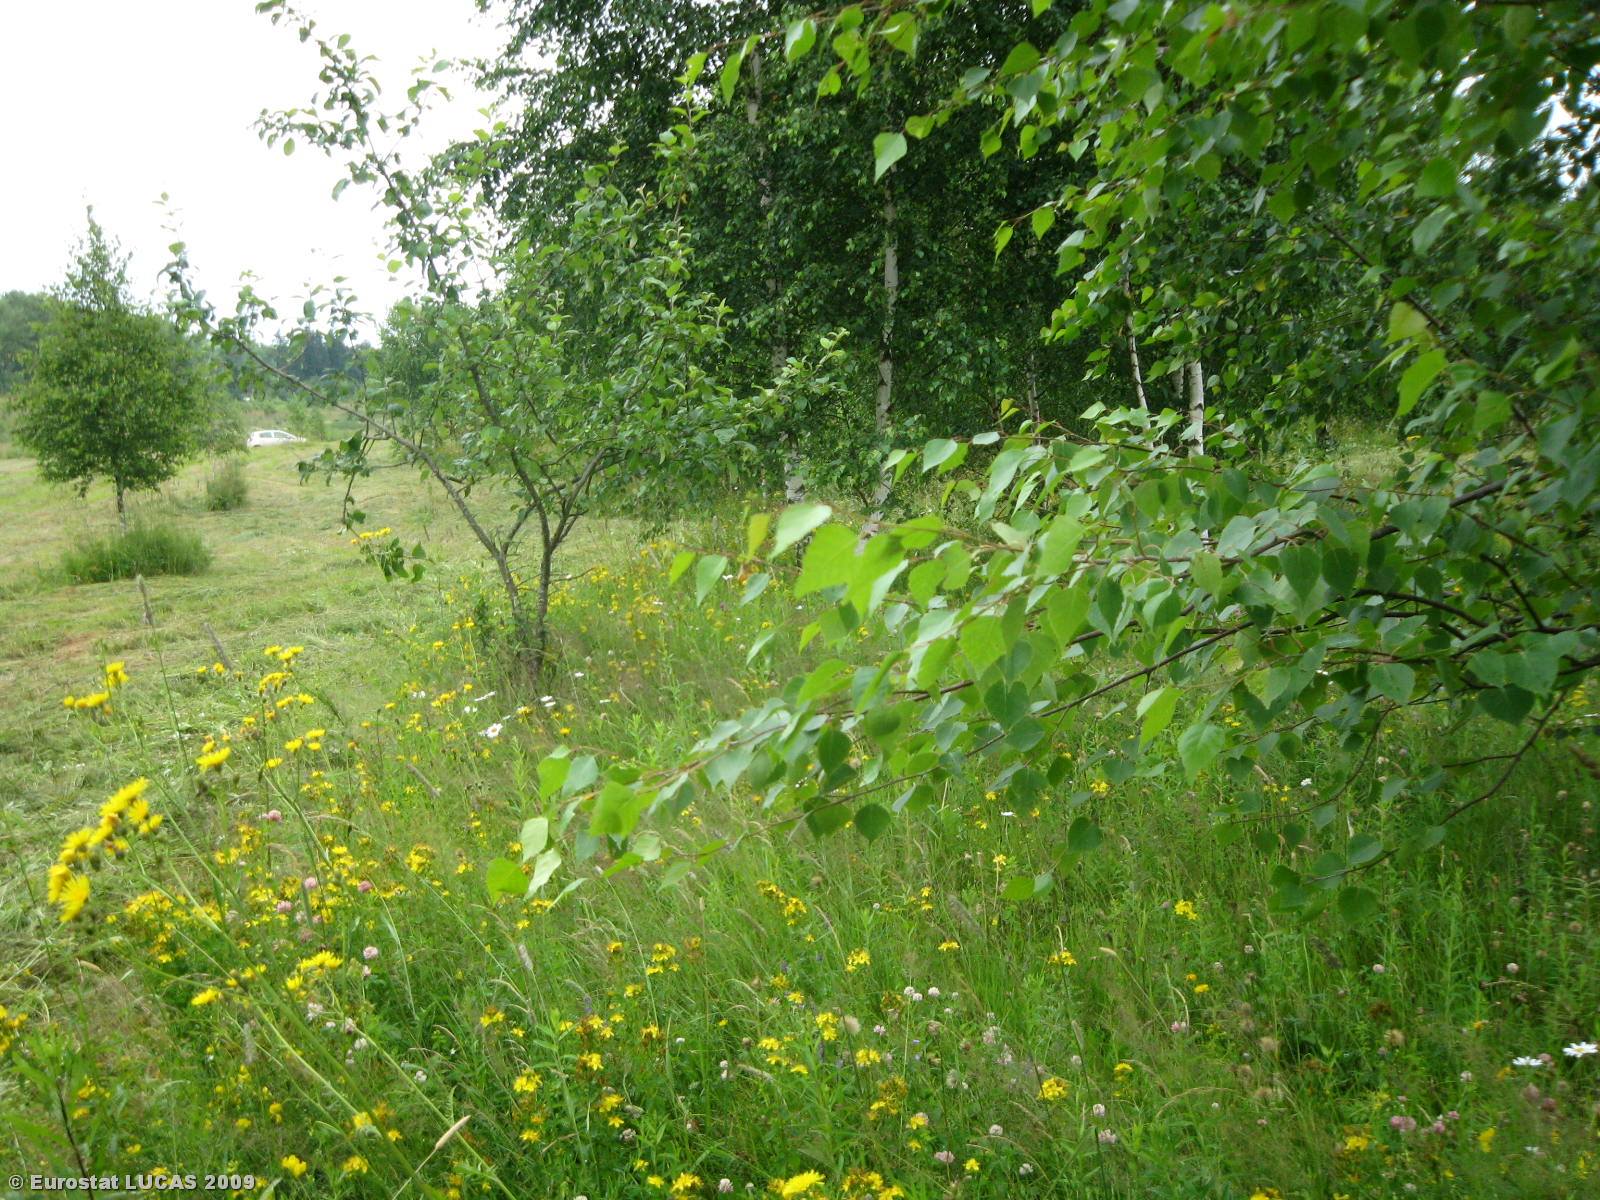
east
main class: Woodland
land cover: Broadleaved woodland
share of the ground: 25 - 50 %
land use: Forestry
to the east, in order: Broadleaved woodland; Tracks; Grassland without tree/shrub cover; Shrubland with sparse tree cover; Broadleaved woodland; Shrubland with sparse tree cover
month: July
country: LT
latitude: 55.2226
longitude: 24.8710
